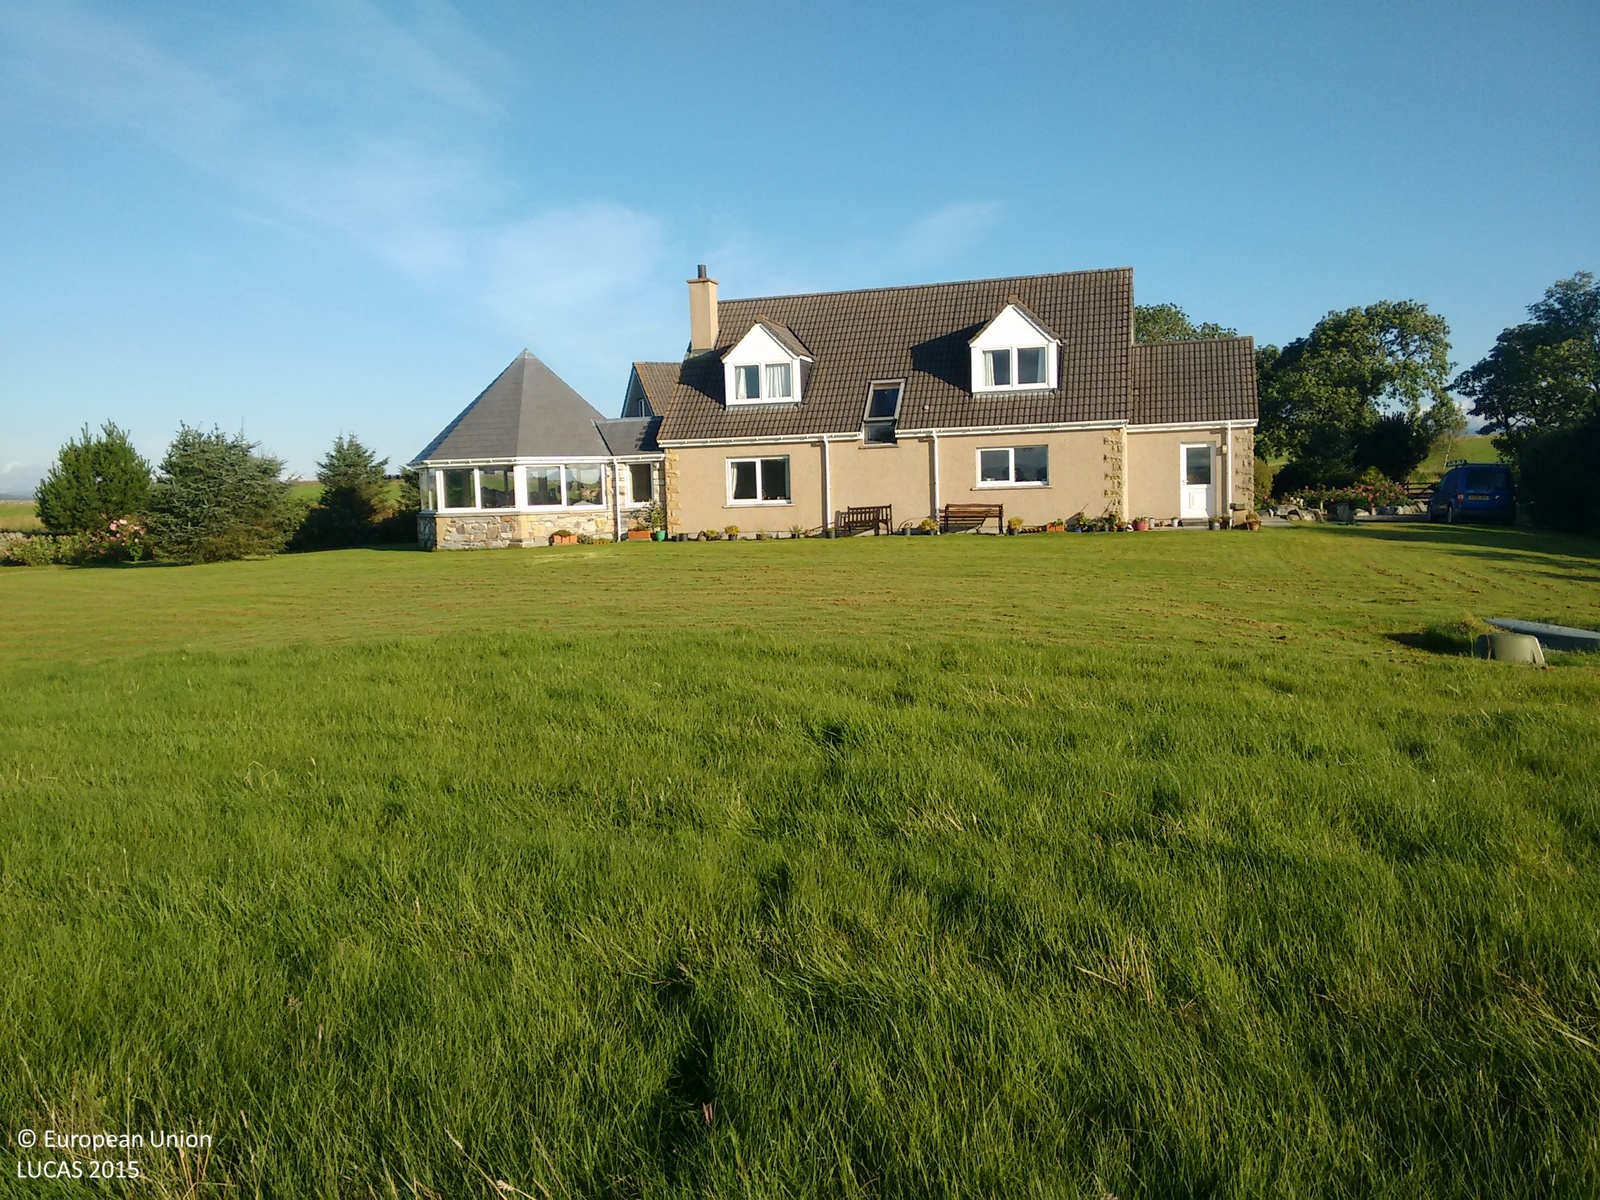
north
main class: Grassland
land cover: Grassland without tree/shrub cover
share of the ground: > 75 %
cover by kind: herbaceous plants 100 %
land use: Residential
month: September
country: GB
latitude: 58.0567
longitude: -4.4398
